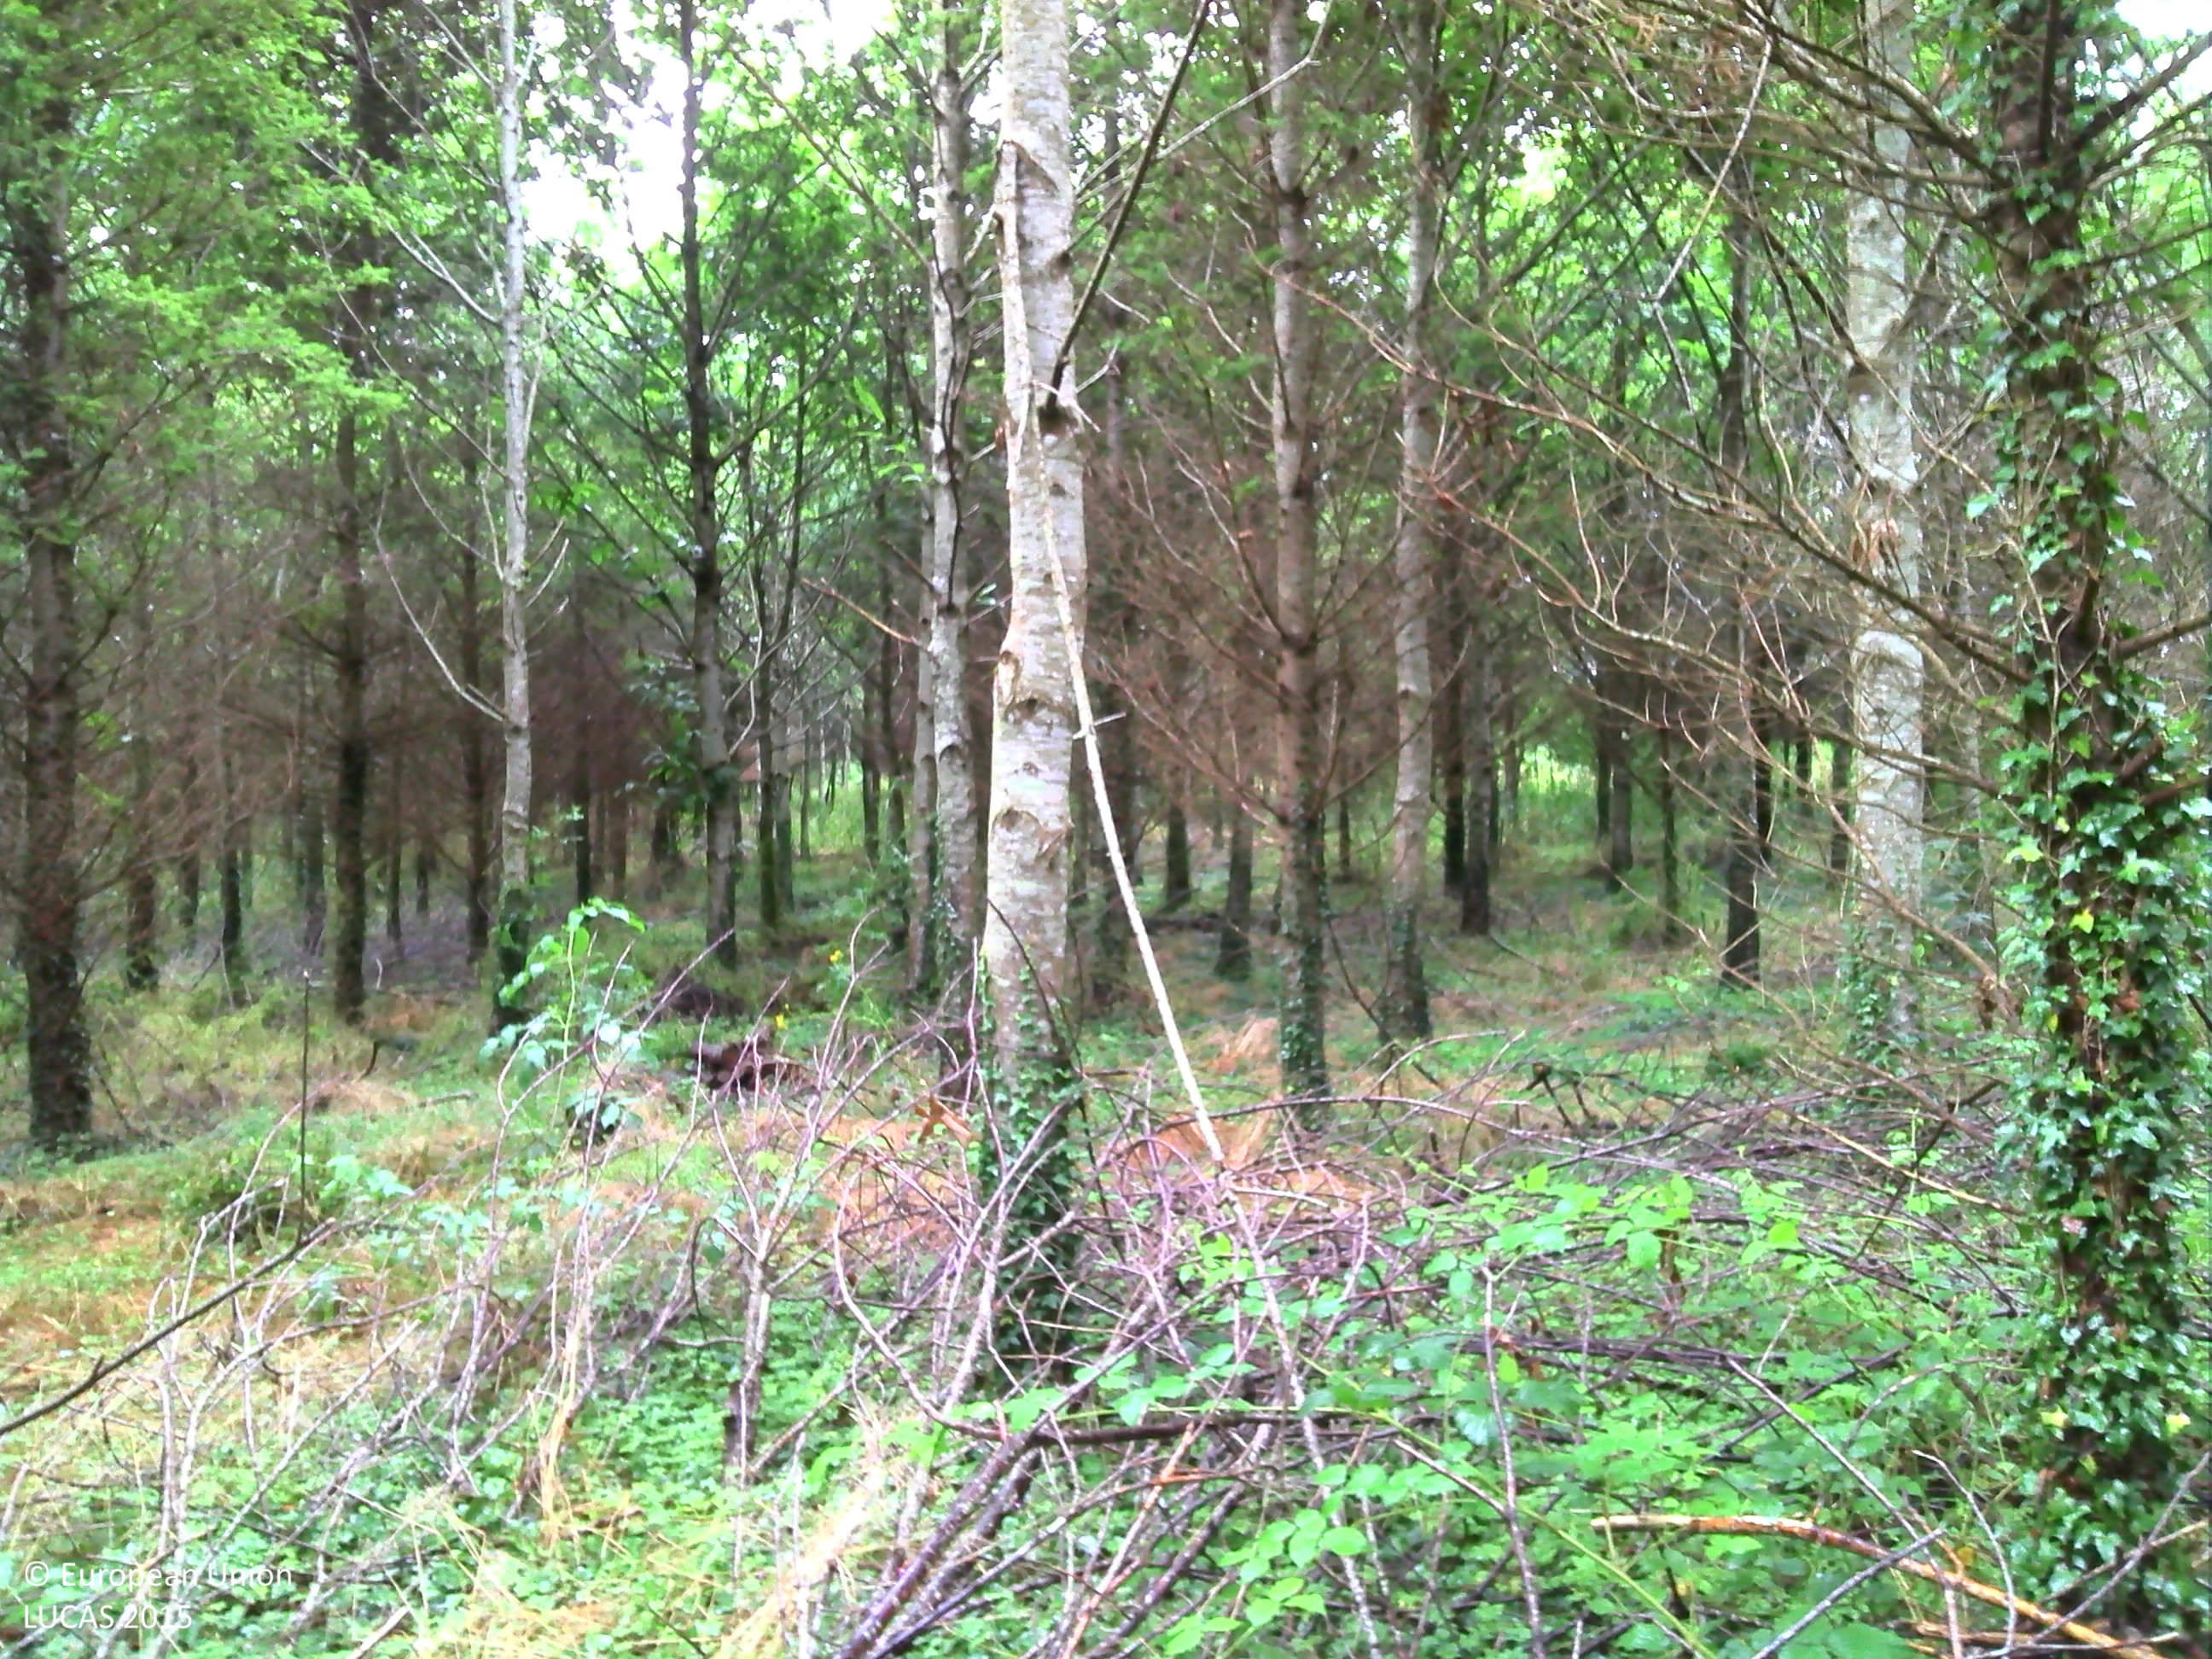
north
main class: Woodland
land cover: Spruce dominated mixed woodland
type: exotic forest
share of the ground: > 75 %
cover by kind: broadleaved forest trees 50 %, coniferous forest trees 25 %, shrubs 10 %, herbaceous plants 10 %, consolidated bare surface 5 %
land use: Forestry
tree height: > 5 m
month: July
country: FR
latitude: 47.9961
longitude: -3.6007
